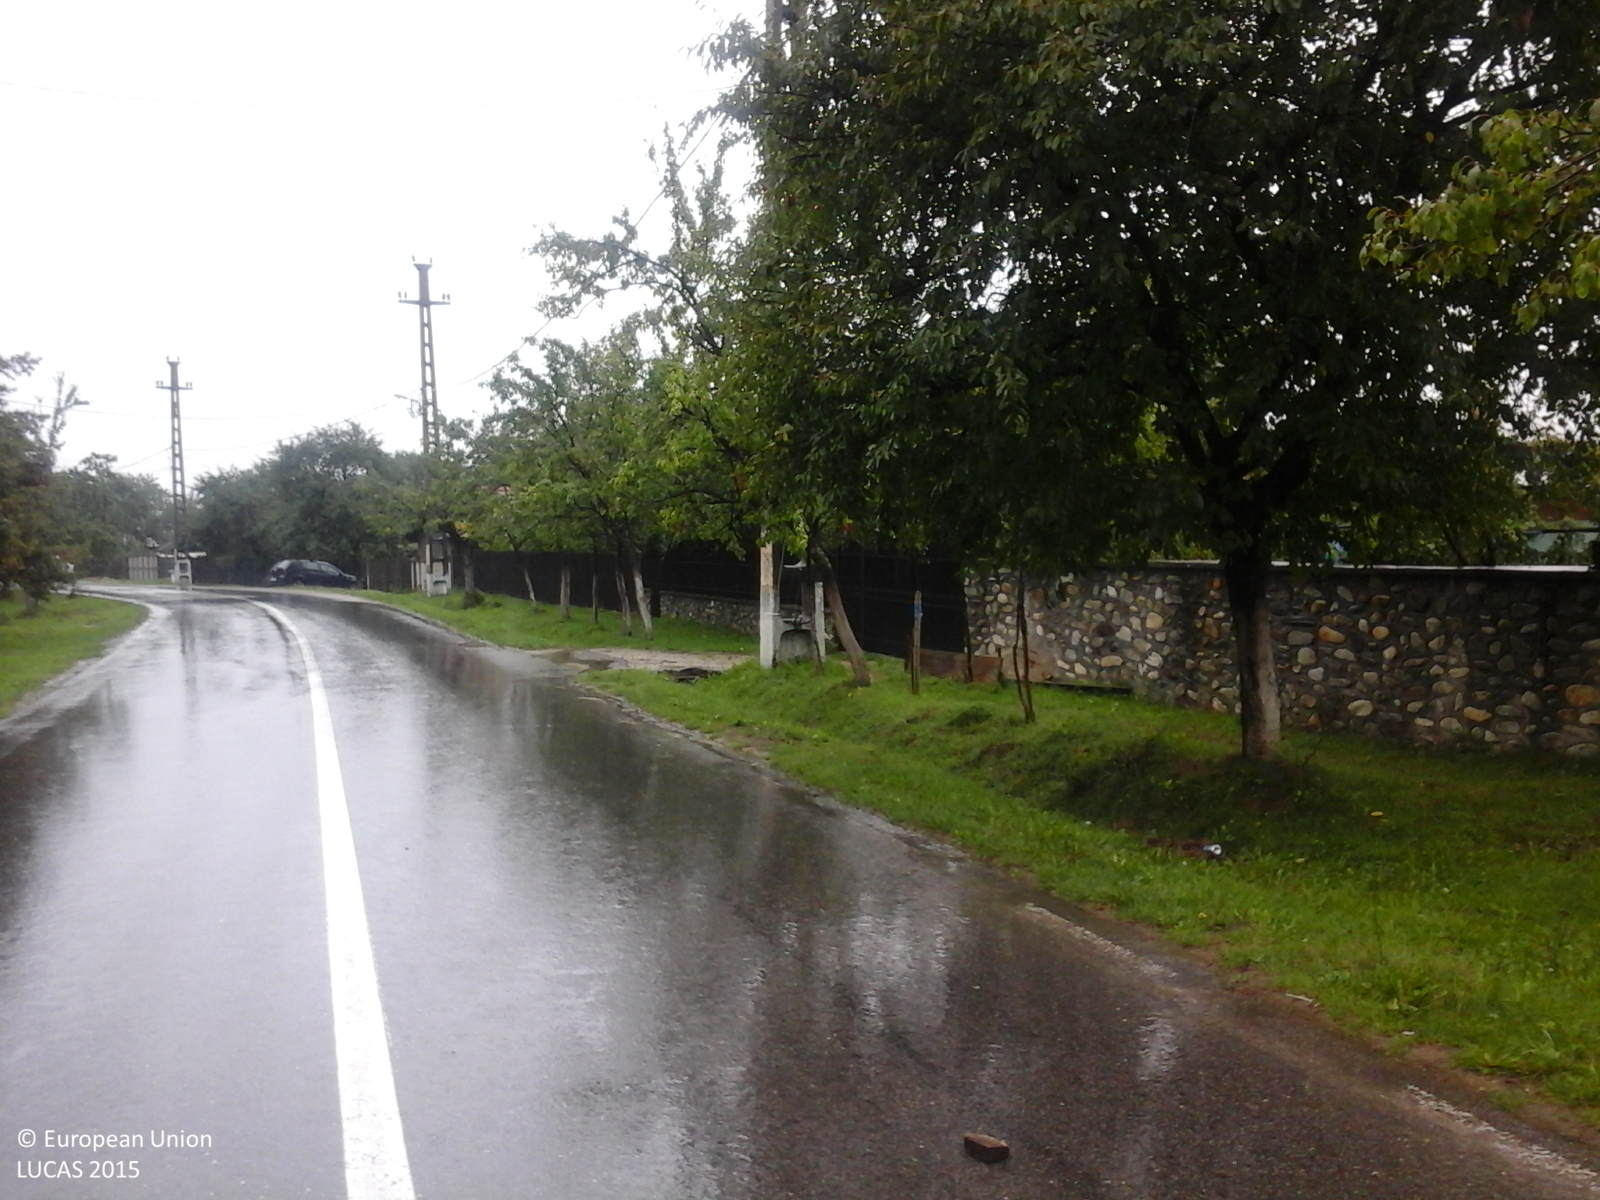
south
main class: Grassland
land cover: Spontaneously vegetated surfaces
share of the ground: > 75 %
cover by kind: herbaceous plants 100 %
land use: Agriculture (excluding fallow land and kitchen gardens)
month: September
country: RO
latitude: 45.1783
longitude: 23.7944
